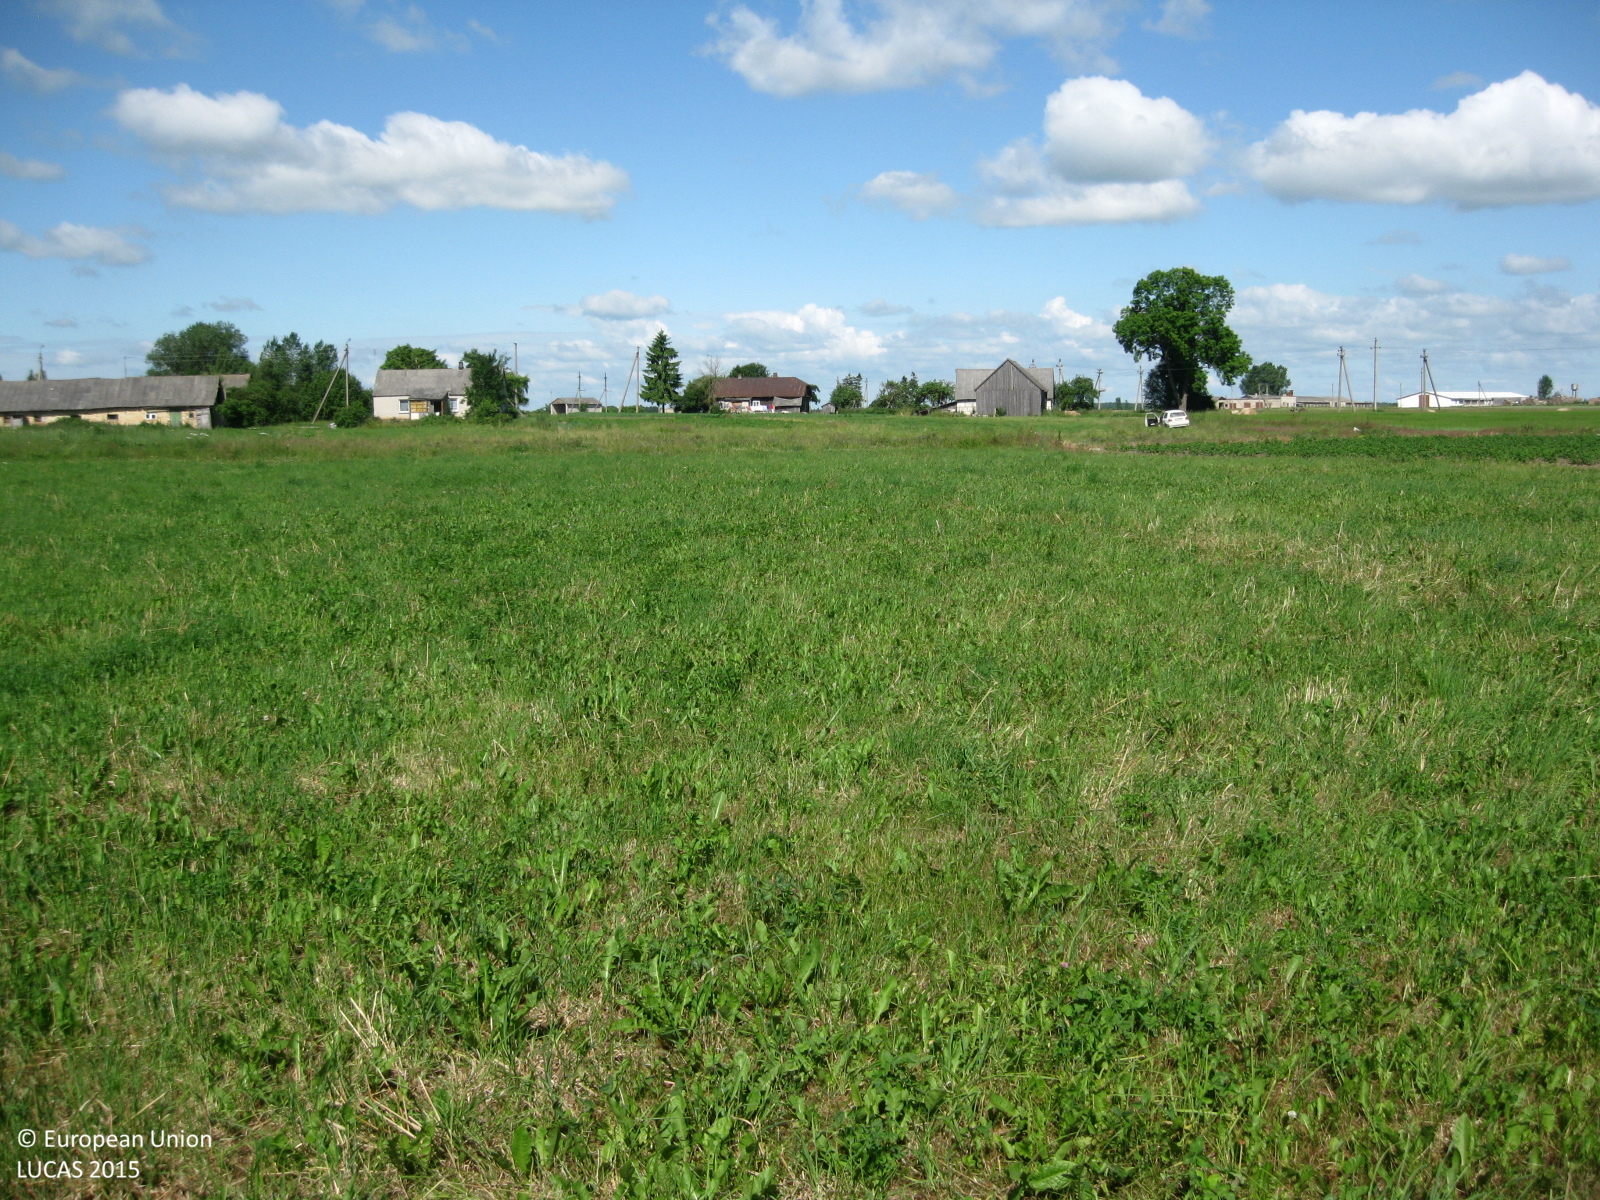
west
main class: Grassland
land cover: Grassland without tree/shrub cover
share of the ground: > 75 %
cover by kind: herbaceous plants 90 %, unconsolidated bare surface 10 %
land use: Agriculture (excluding fallow land and kitchen gardens)
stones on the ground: < 10 %
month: June
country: LT
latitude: 55.4320
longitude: 24.1740
